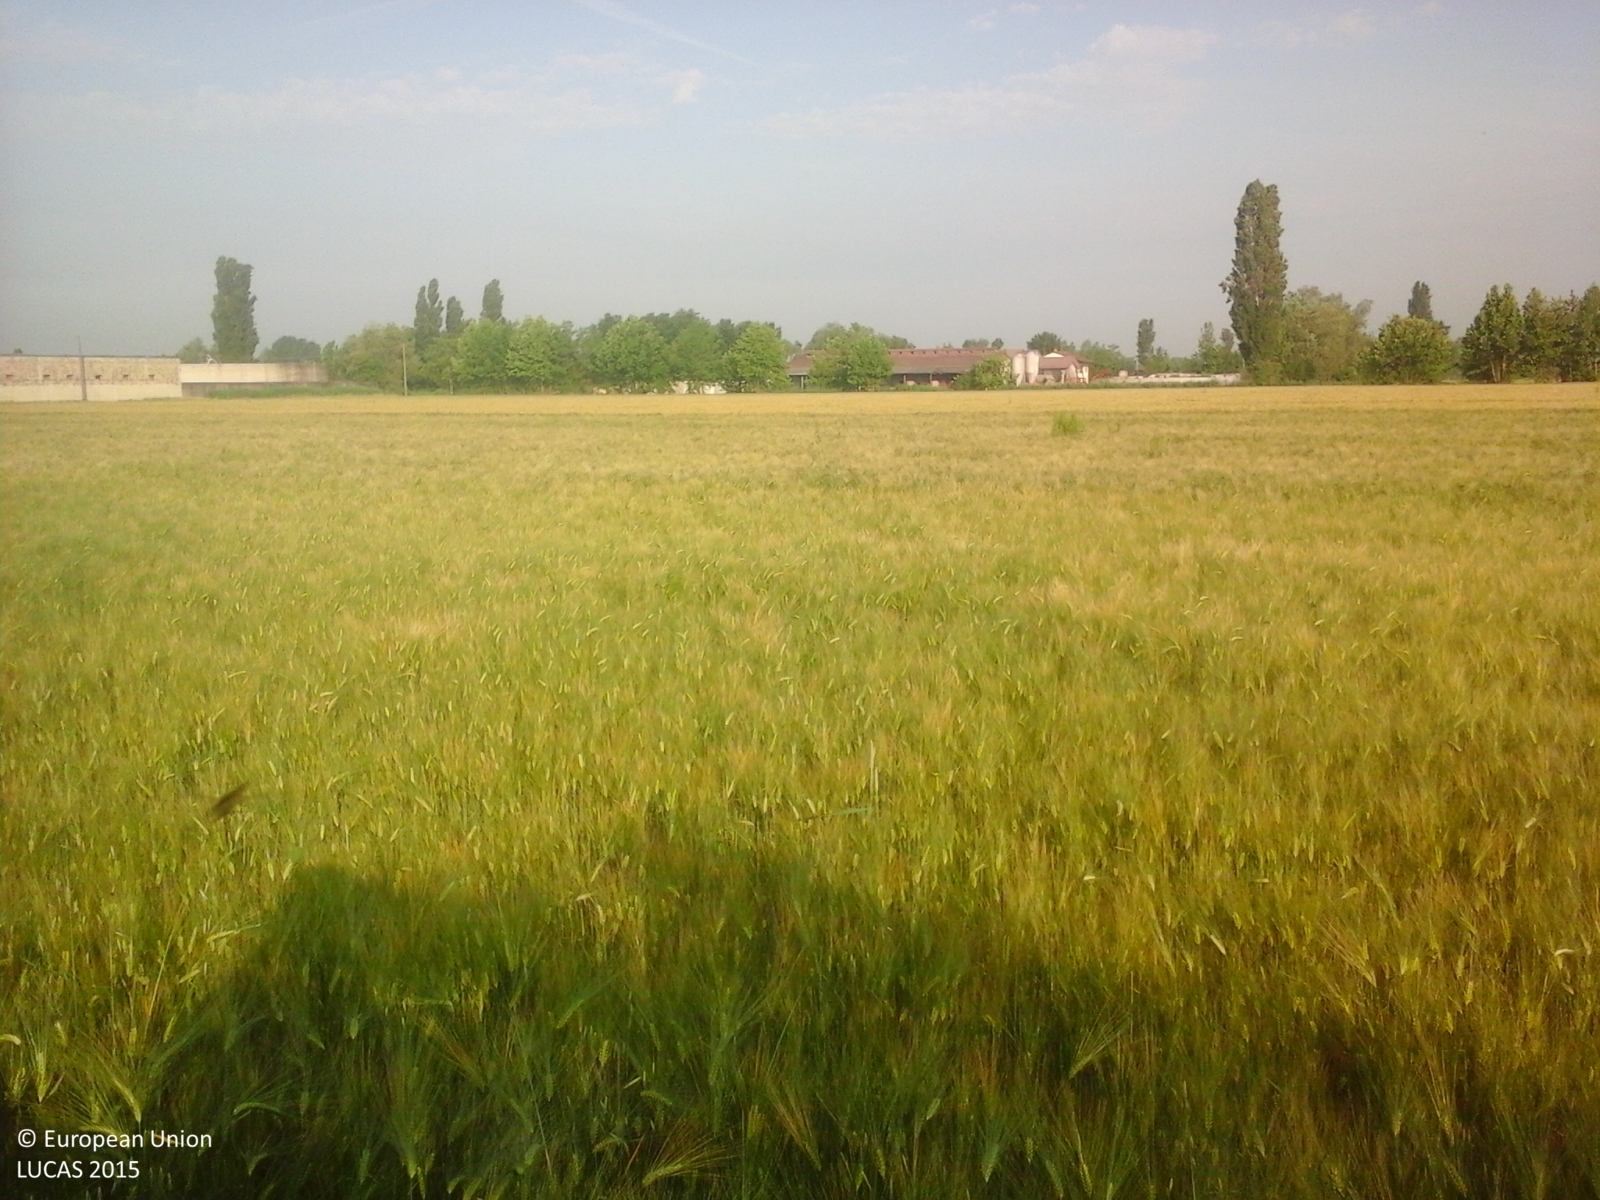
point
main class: Cropland
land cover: Common wheat
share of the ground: > 75 %
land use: Agriculture (excluding fallow land and kitchen gardens)
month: May
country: IT
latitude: 45.3410
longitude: 10.4968
